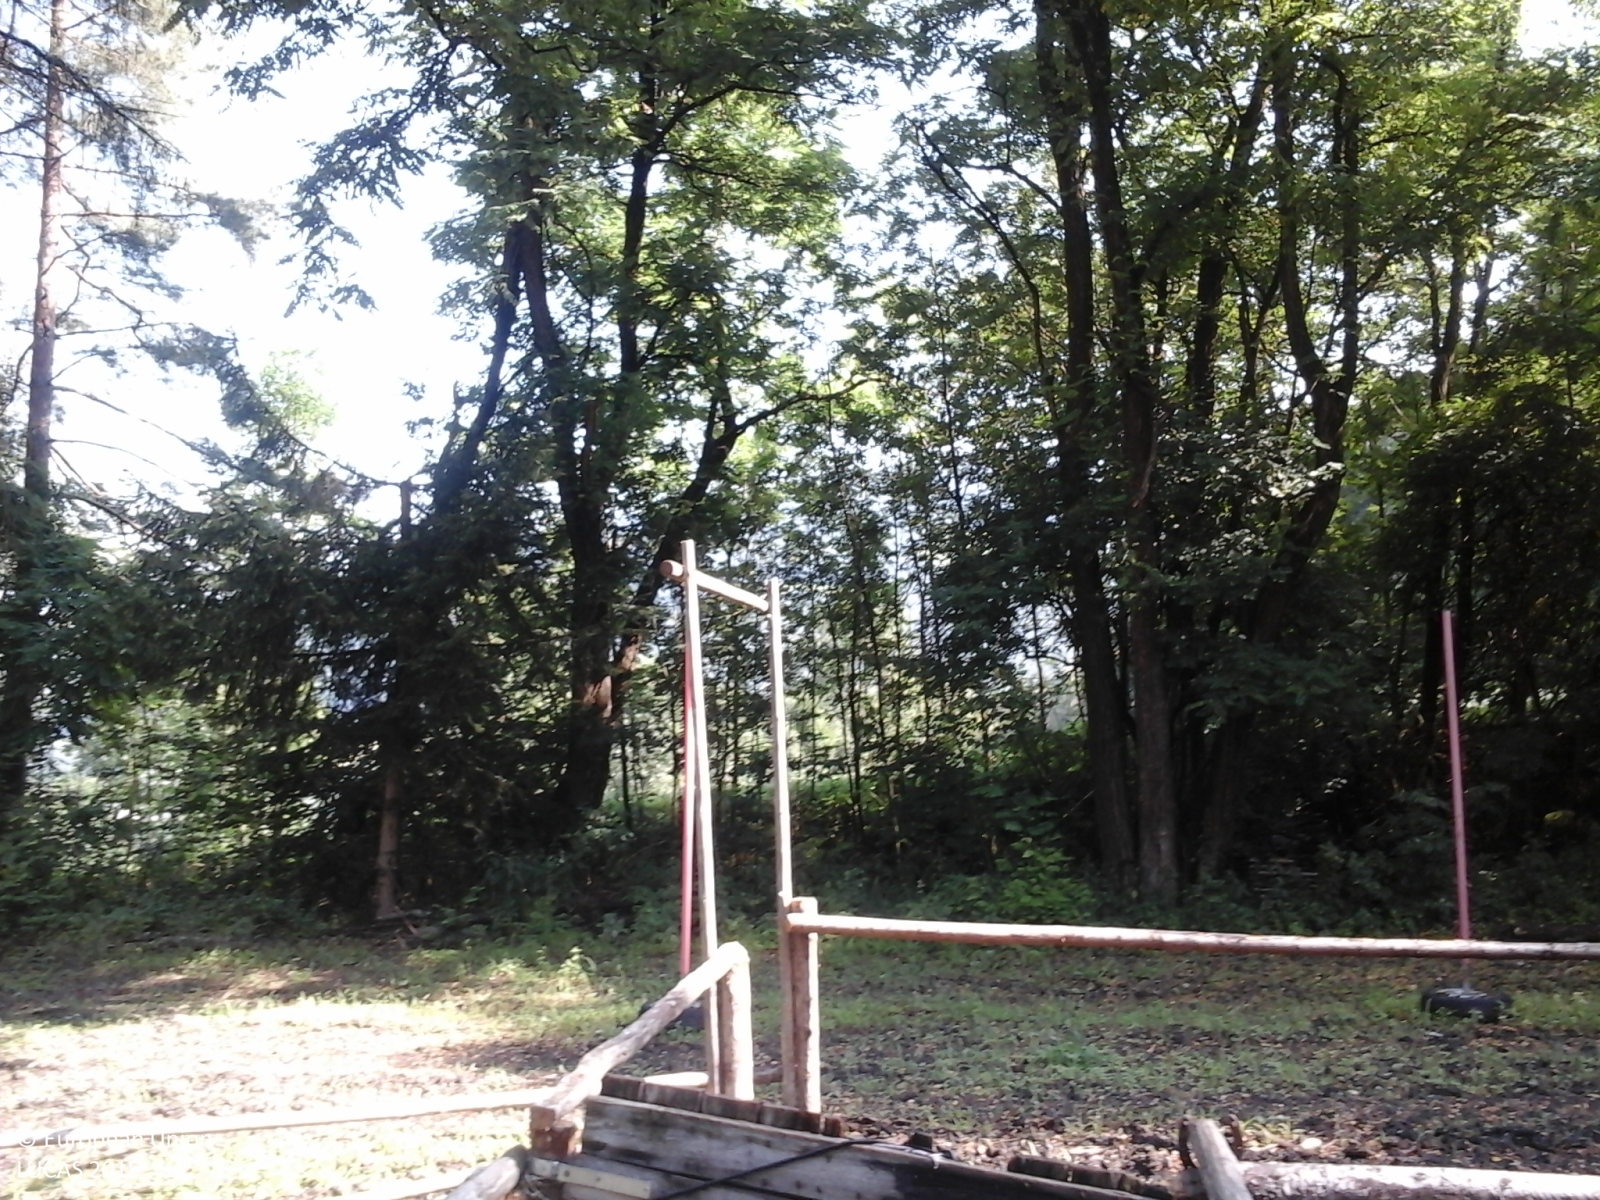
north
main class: Grassland
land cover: Spontaneously vegetated surfaces
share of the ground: > 75 %
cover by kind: consolidated bare surface 80 %, herbaceous plants 20 %
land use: Sport
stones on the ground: < 10 %
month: July
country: IT
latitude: 46.7833
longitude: 11.9758
